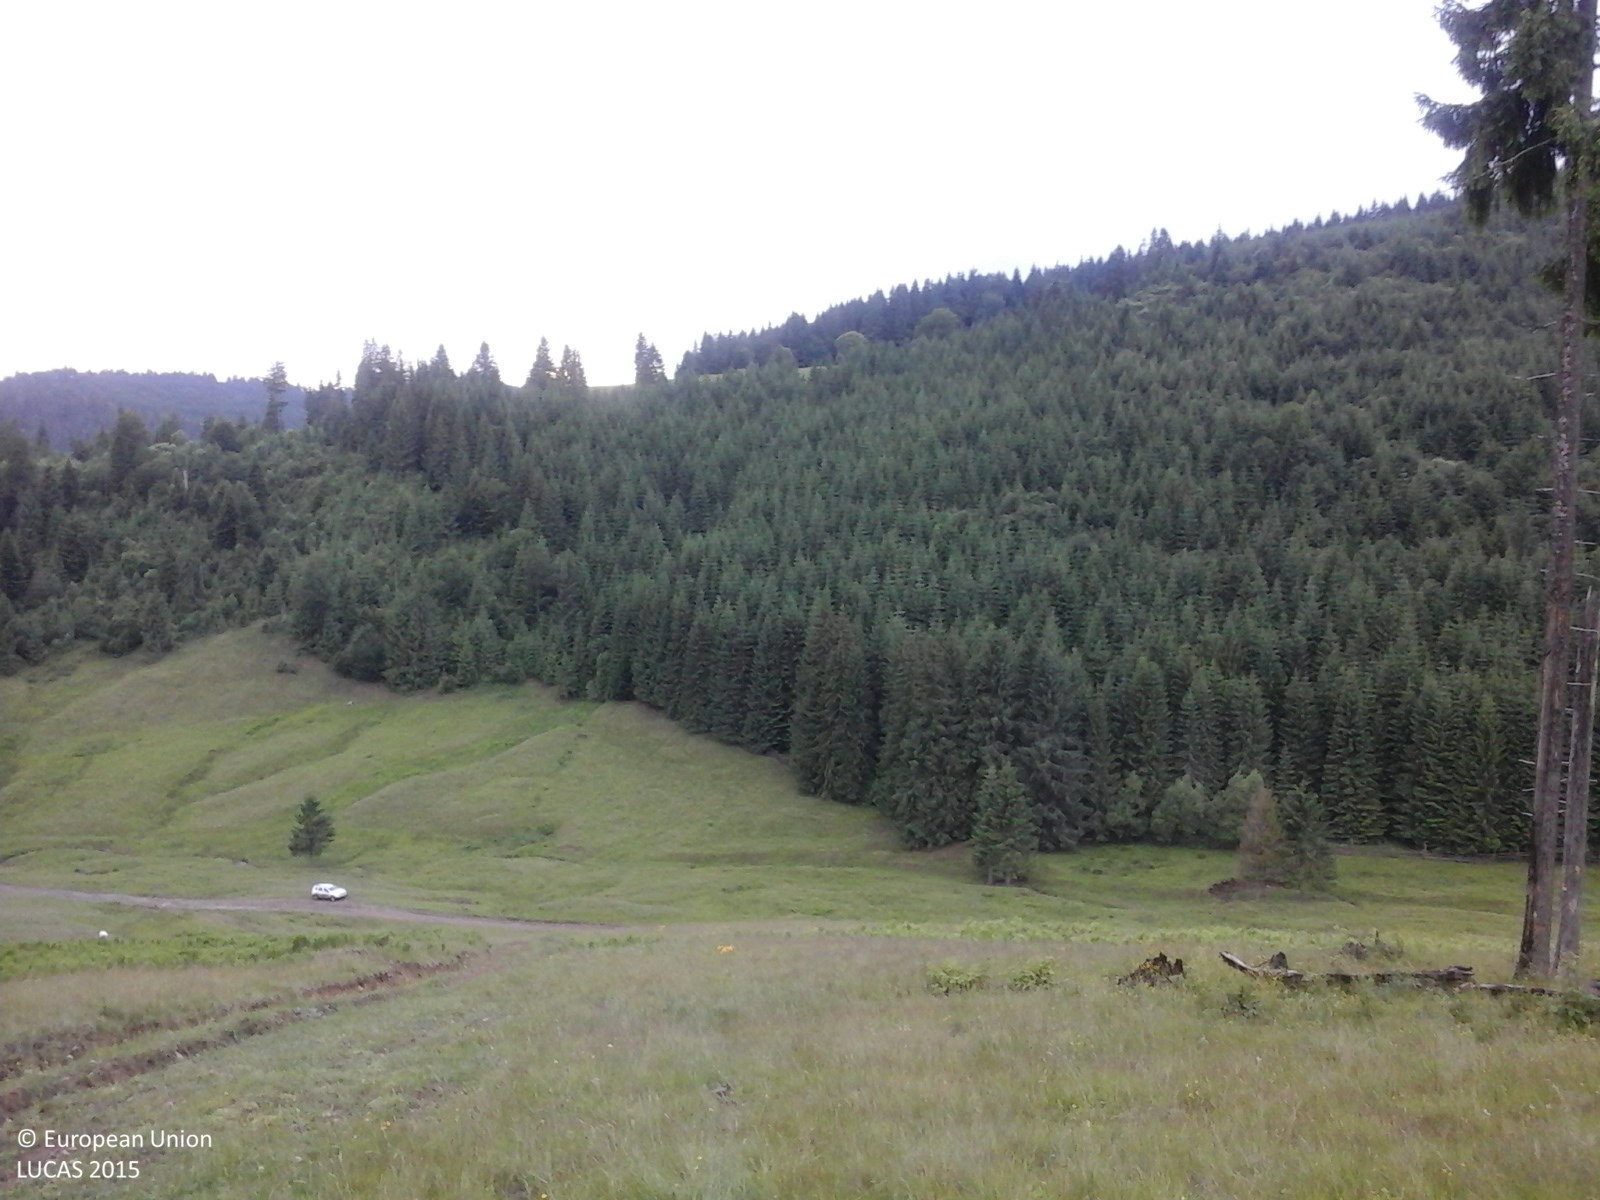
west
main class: Grassland
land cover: Grassland without tree/shrub cover
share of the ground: > 75 %
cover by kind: herbaceous plants 100 %
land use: Agriculture (excluding fallow land and kitchen gardens)
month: June
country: RO
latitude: 47.3754
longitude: 25.1115
